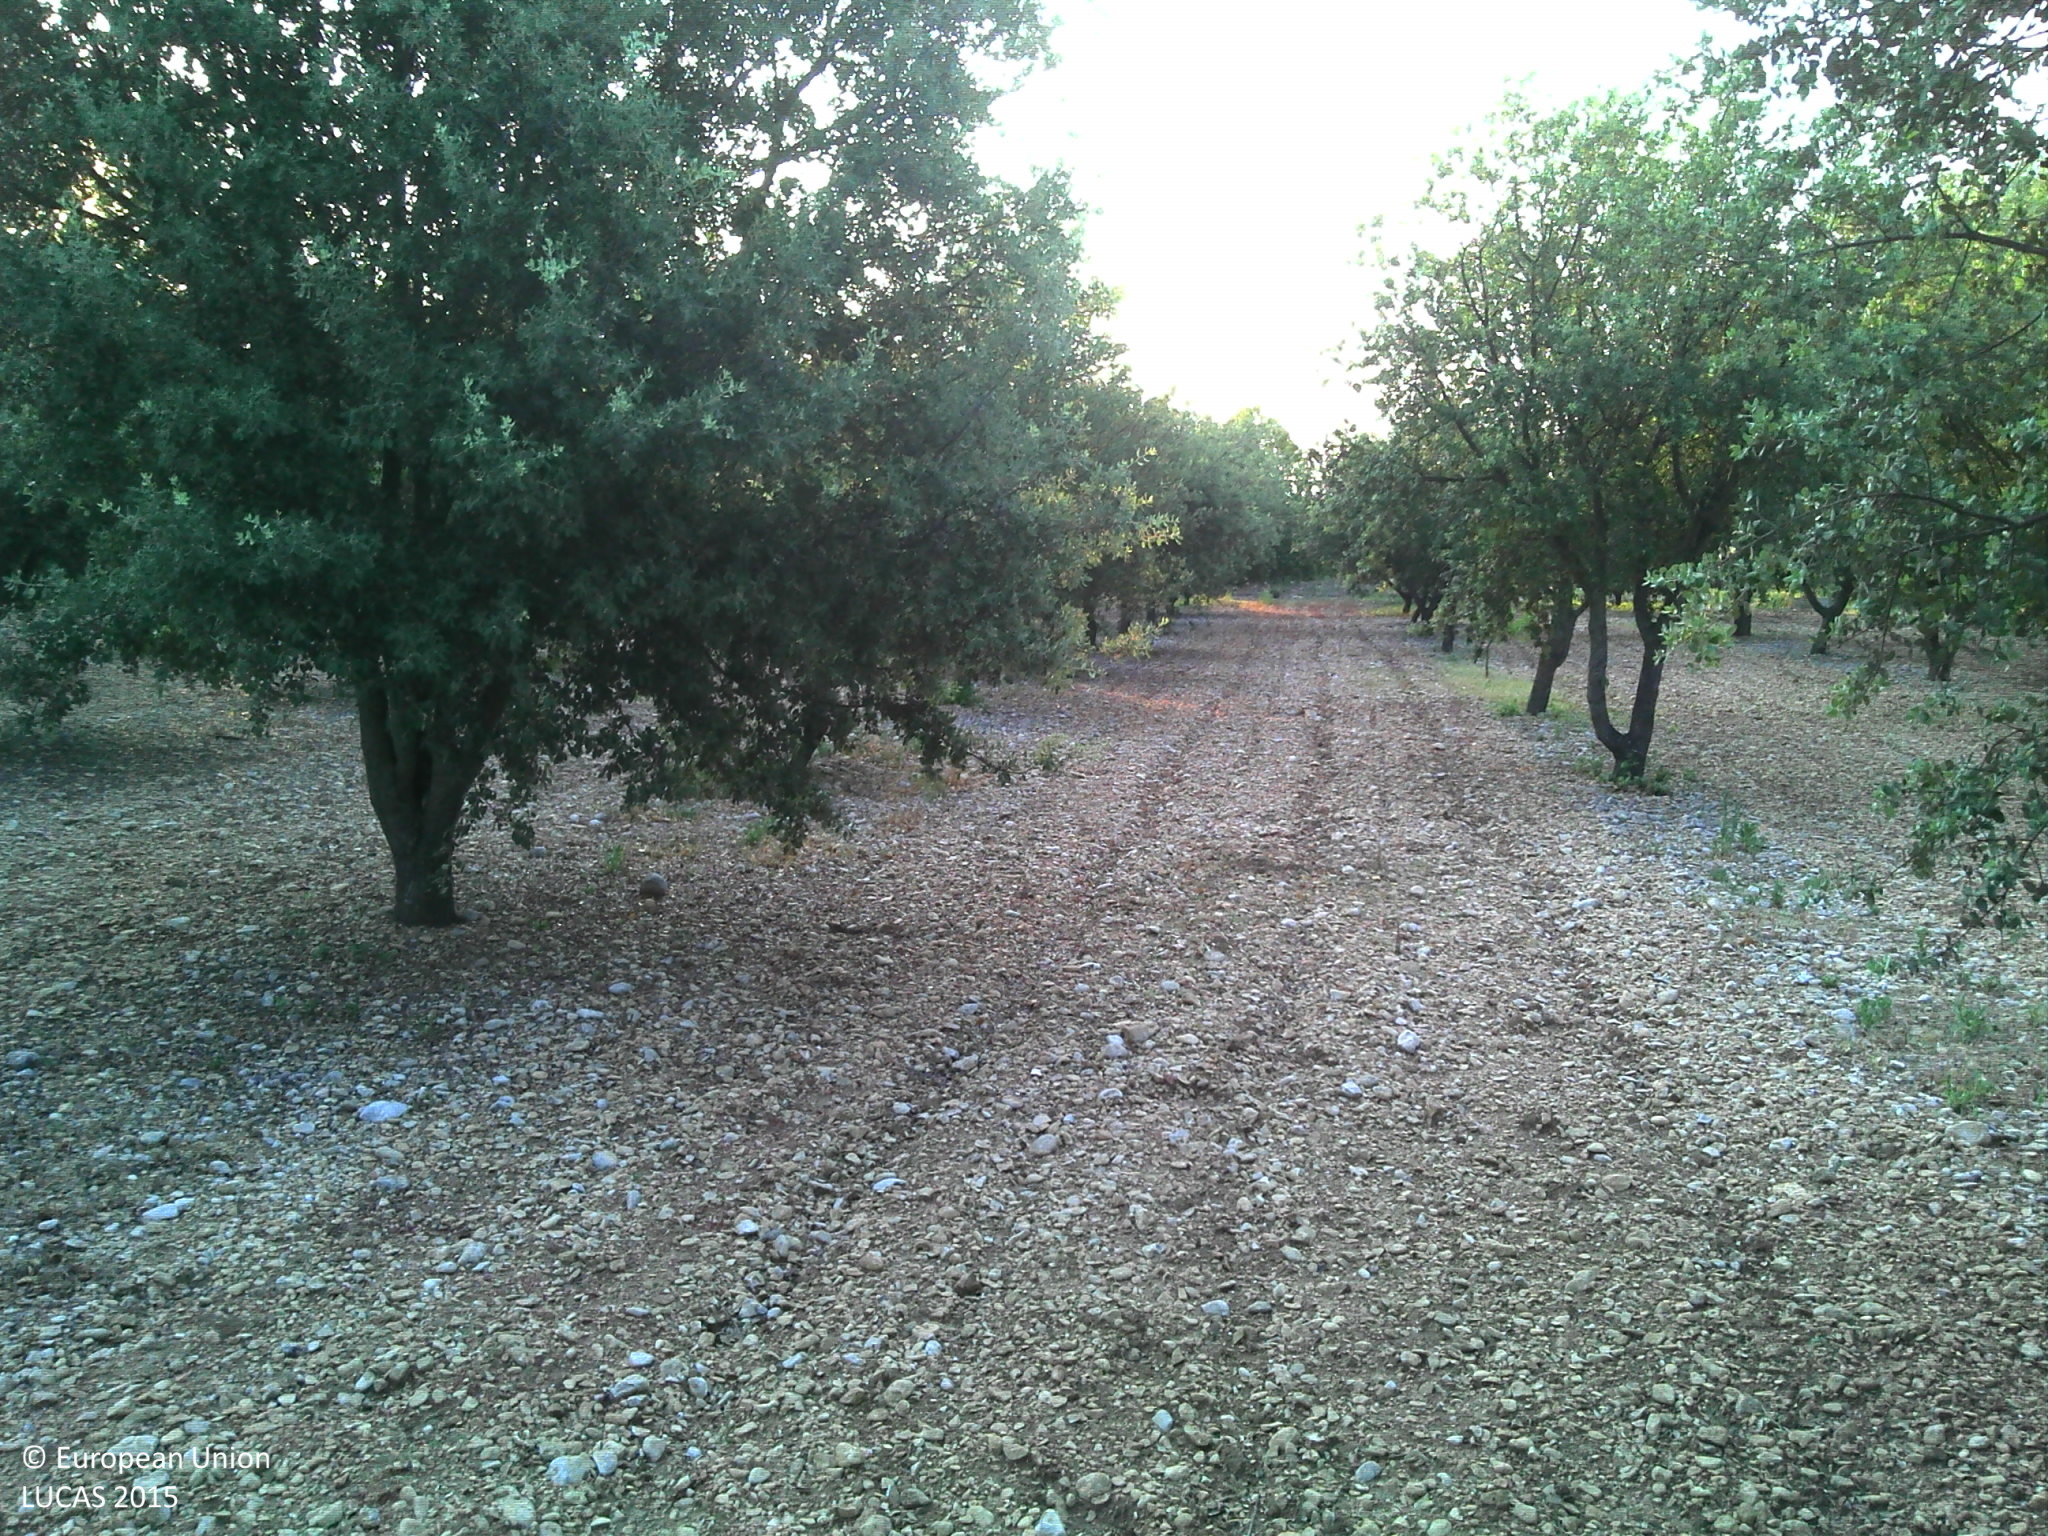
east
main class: Cropland
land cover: Pear fruit
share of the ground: 25 - 50 %
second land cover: Other bare soil
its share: > 75 %
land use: Agriculture (excluding fallow land and kitchen gardens)
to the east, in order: Pear fruit; Other bare soil; Fences; Artificial constructions; Grass margins; Ditches and canals; Grass margins; Paved roads, cycling and walking lanes; Grass margins; Ditches and canals; Lines of trees; Other bare soil; Grass margins; Ditches and canals; Fences; Conifer hedges; Nurseries; Broadleaved woodland; Tracks; Grass margins; Inland fresh running water
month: July
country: FR
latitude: 44.0159
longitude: 5.0561
